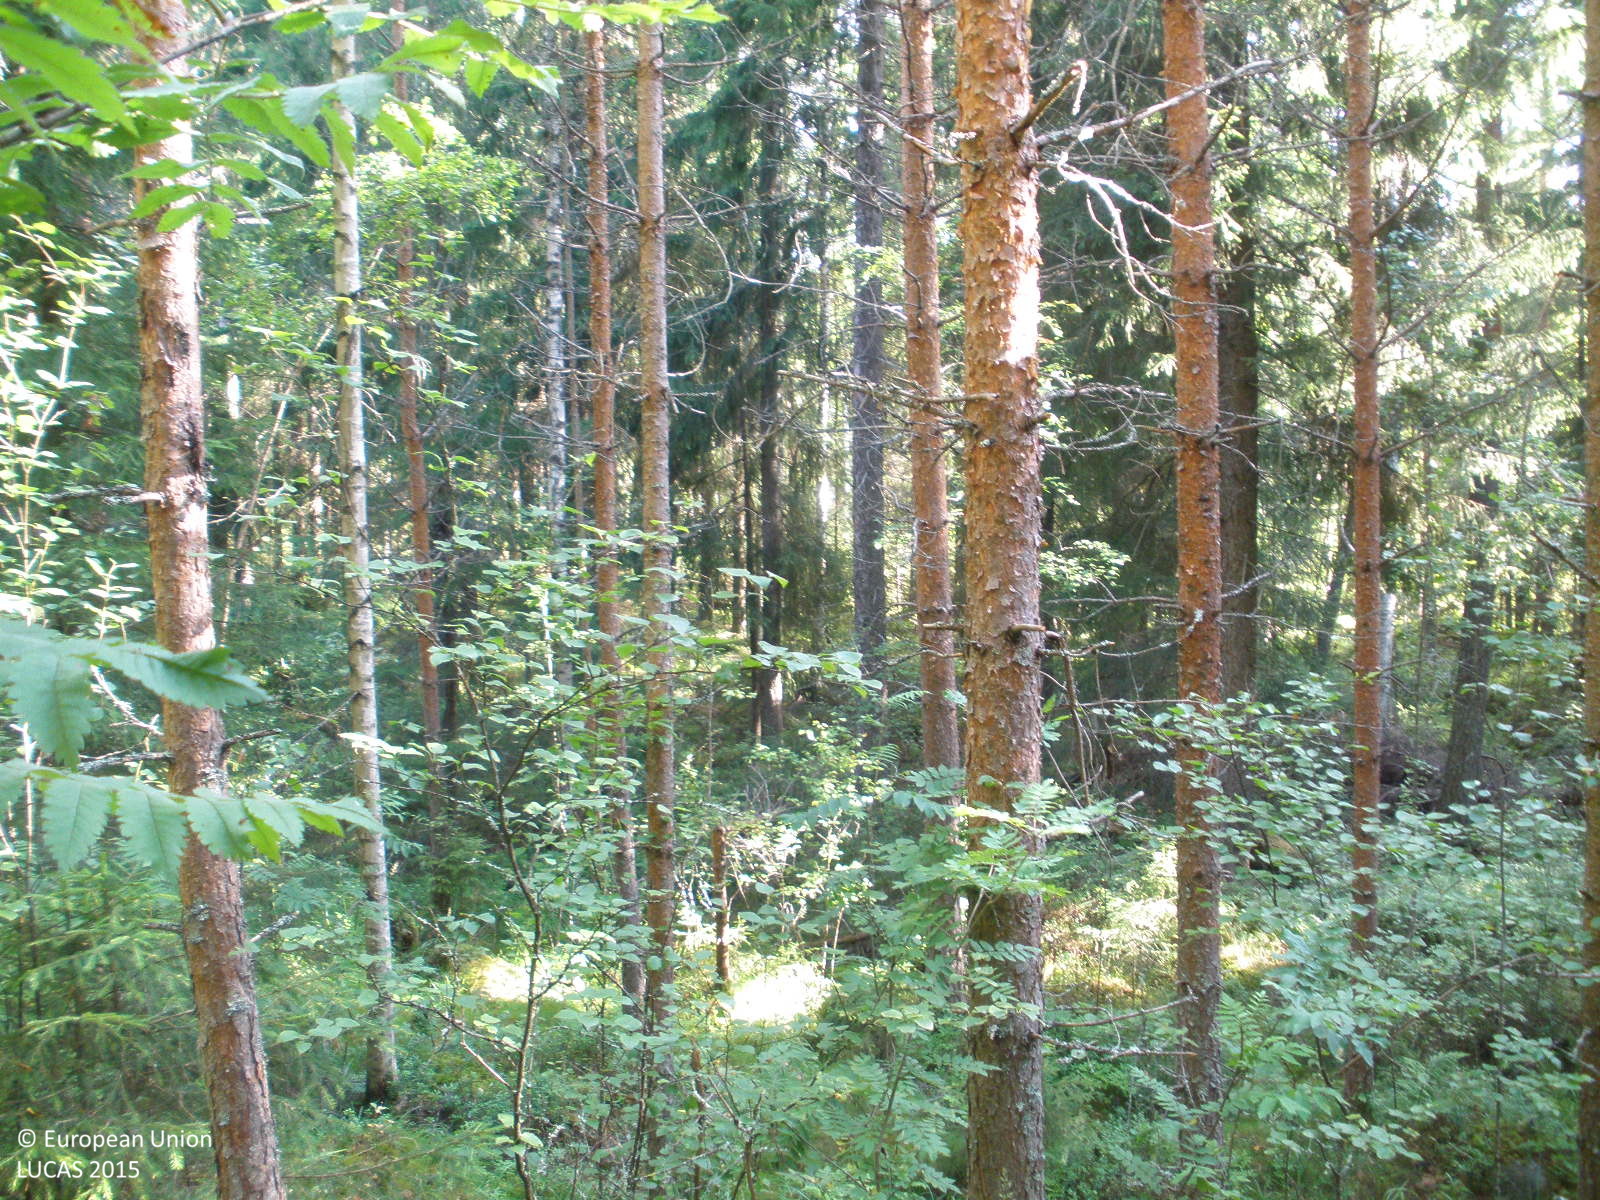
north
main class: Woodland
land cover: Pine dominated mixed woodland
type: boreal forest
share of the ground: > 75 %
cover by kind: coniferous forest trees 60 %, broadleaved forest trees 25 %, lichens and mosses 10 %, herbaceous plants 5 %
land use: Forestry
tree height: > 5 m
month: August
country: FI
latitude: 60.9138
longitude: 24.8450
